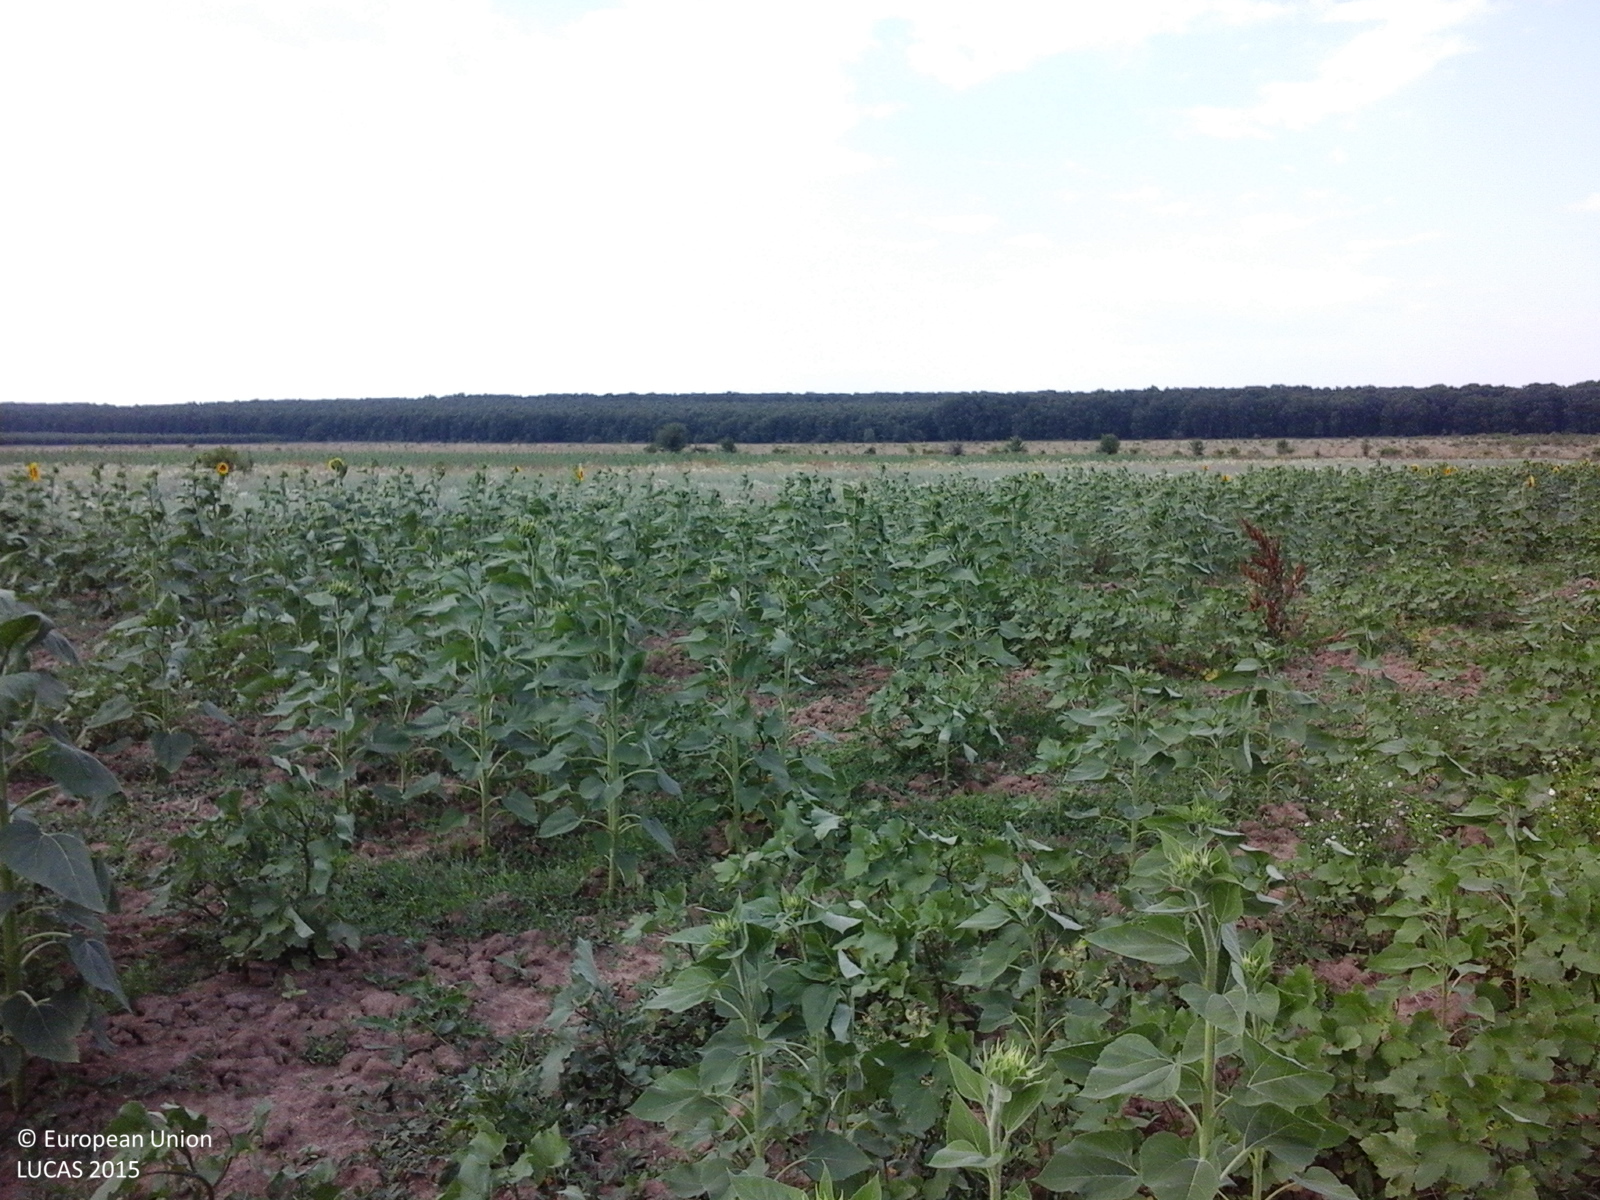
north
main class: Cropland
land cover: Sunflower
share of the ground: > 75 %
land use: Agriculture (excluding fallow land and kitchen gardens)
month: July
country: RO
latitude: 44.1976
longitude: 24.9291
